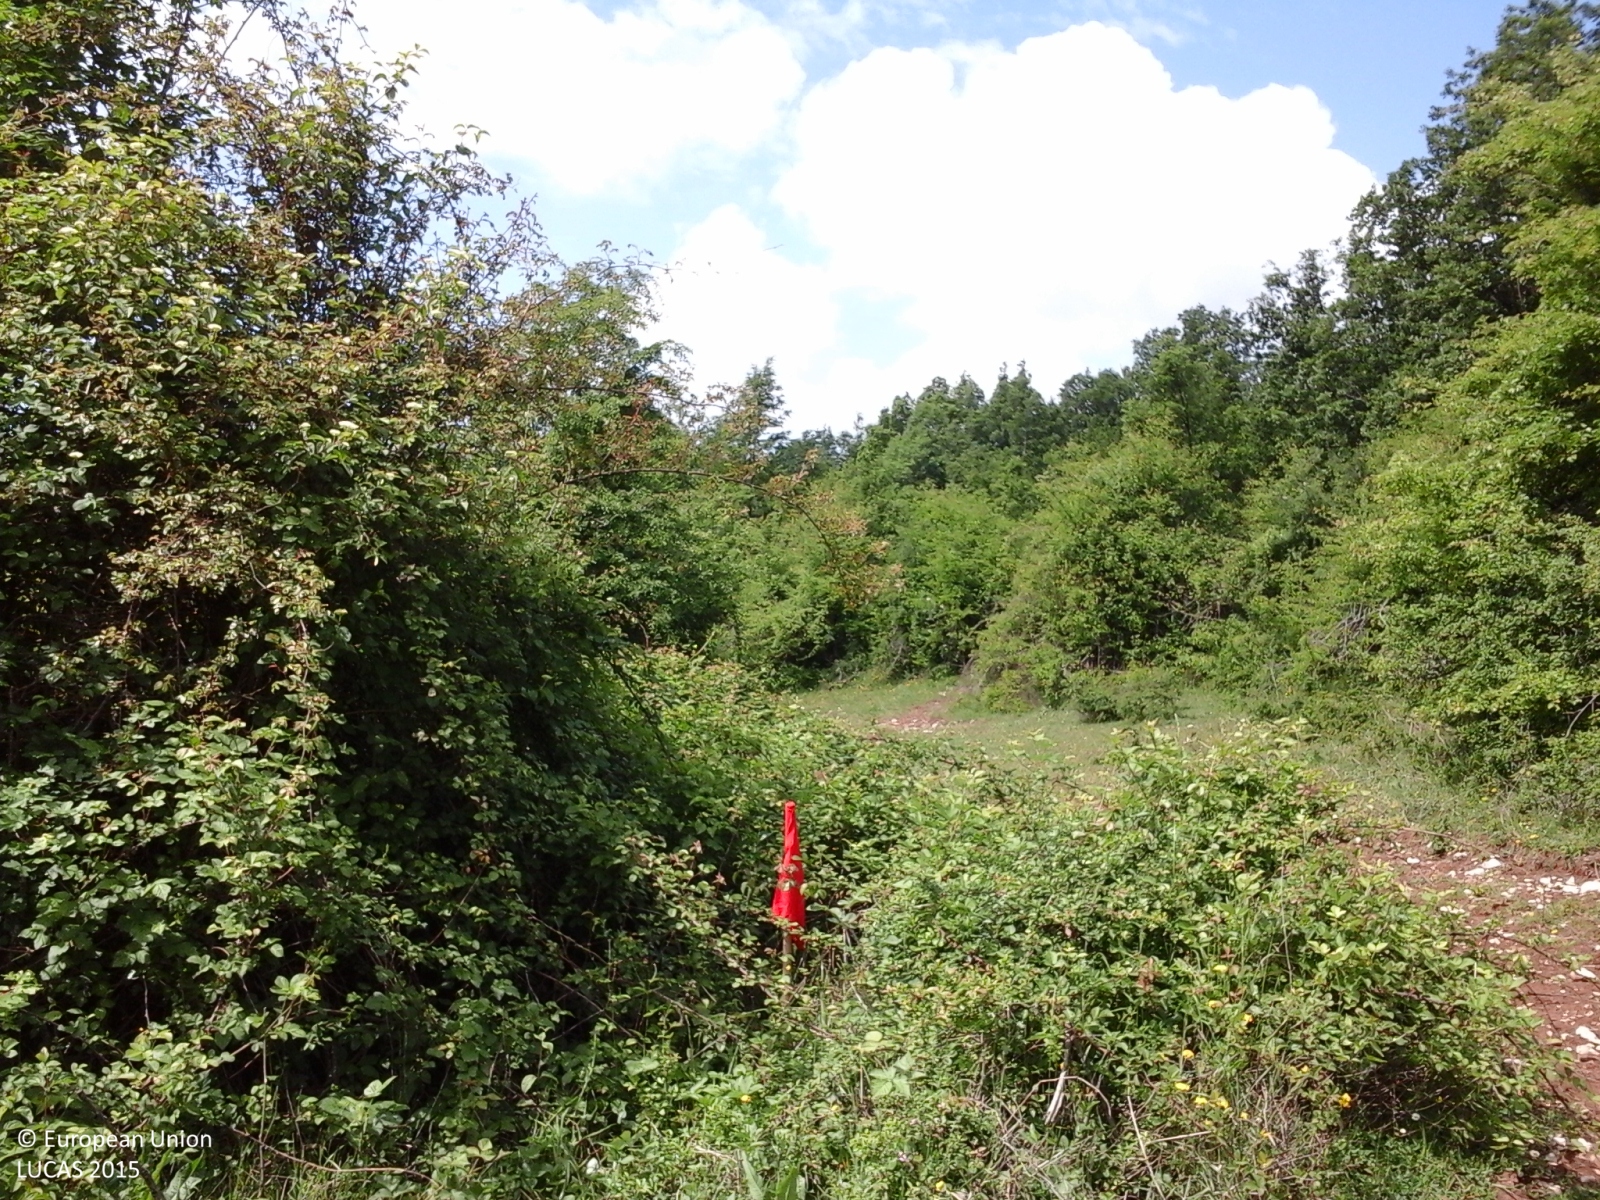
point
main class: Shrubland
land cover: Shrubland with sparse tree cover
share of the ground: 50 - 75 %
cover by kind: shrubs 90 %, broadleaved forest trees 5 %, herbaceous plants 5 %
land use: Forestry
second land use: Agriculture (excluding fallow land and kitchen gardens)
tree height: < 5 m
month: May
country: IT
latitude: 41.8628
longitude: 13.1809
